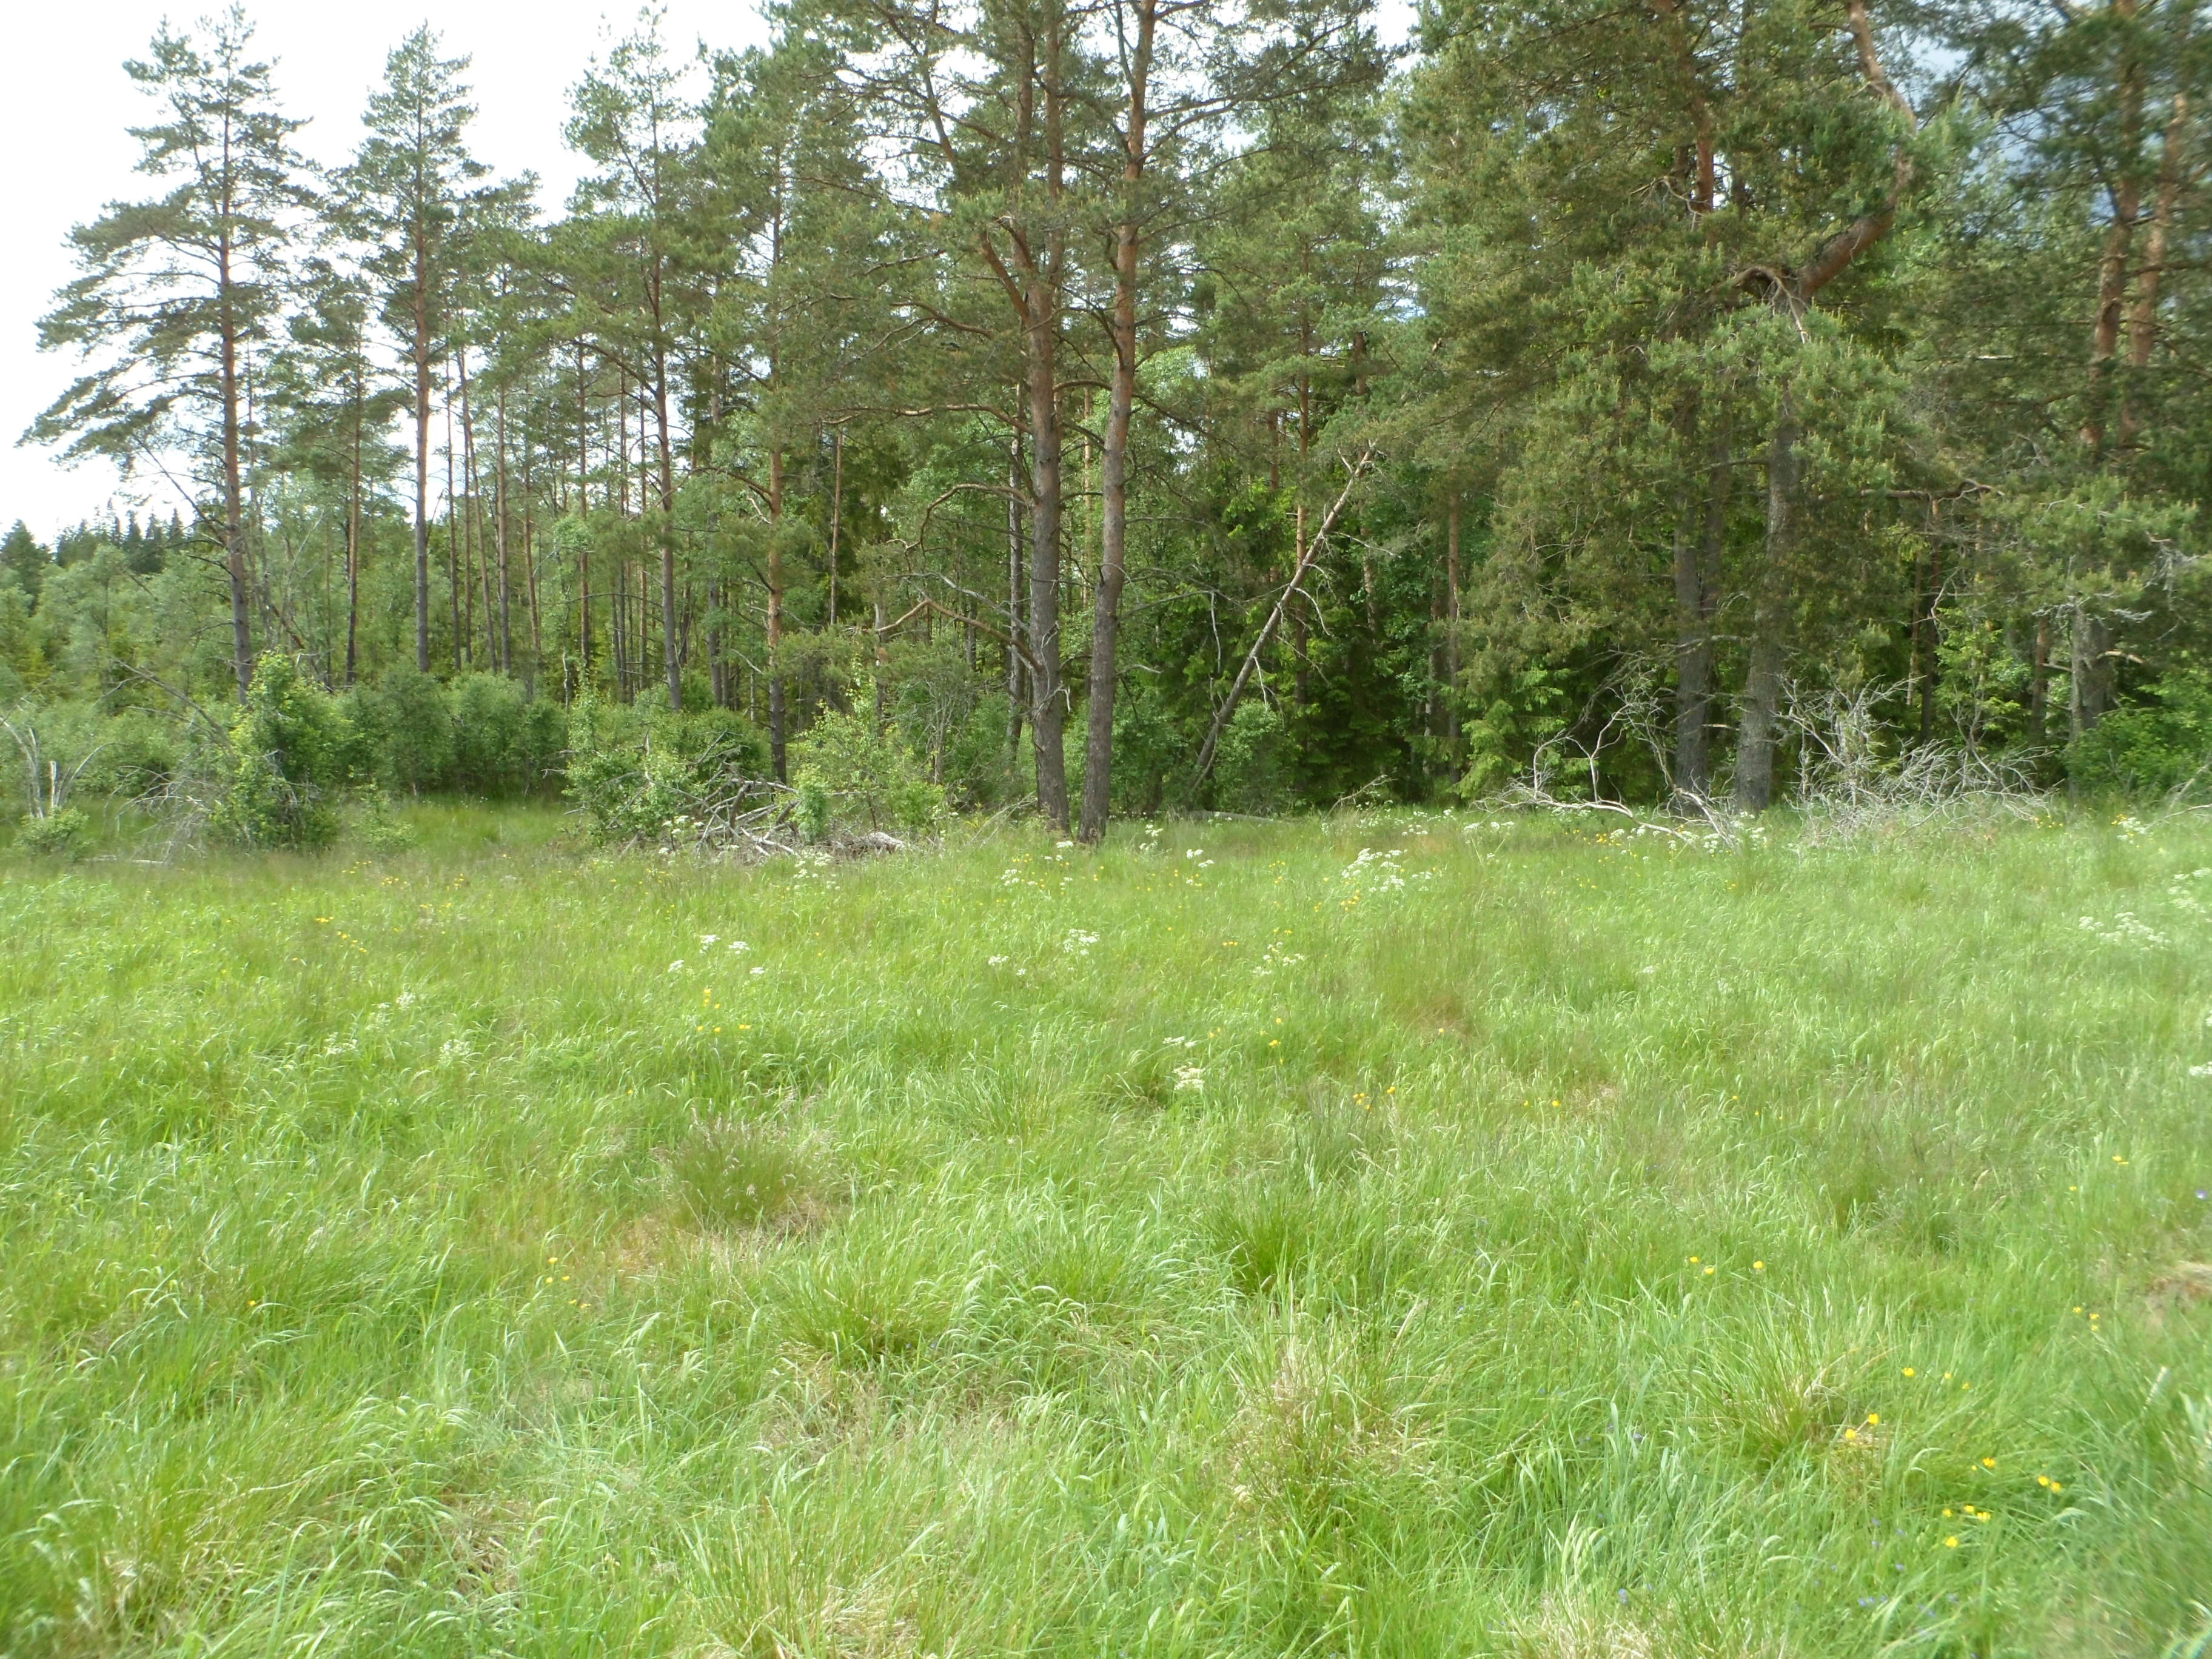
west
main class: Grassland
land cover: Grassland with sparse tree/shrub cover
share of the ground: > 75 %
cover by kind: herbaceous plants 90 %, broadleaved forest trees 5 %, shrubs 5 %
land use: Agriculture (excluding fallow land and kitchen gardens)
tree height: < 5 m
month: June
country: SE
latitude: 57.3086
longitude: 14.1626
